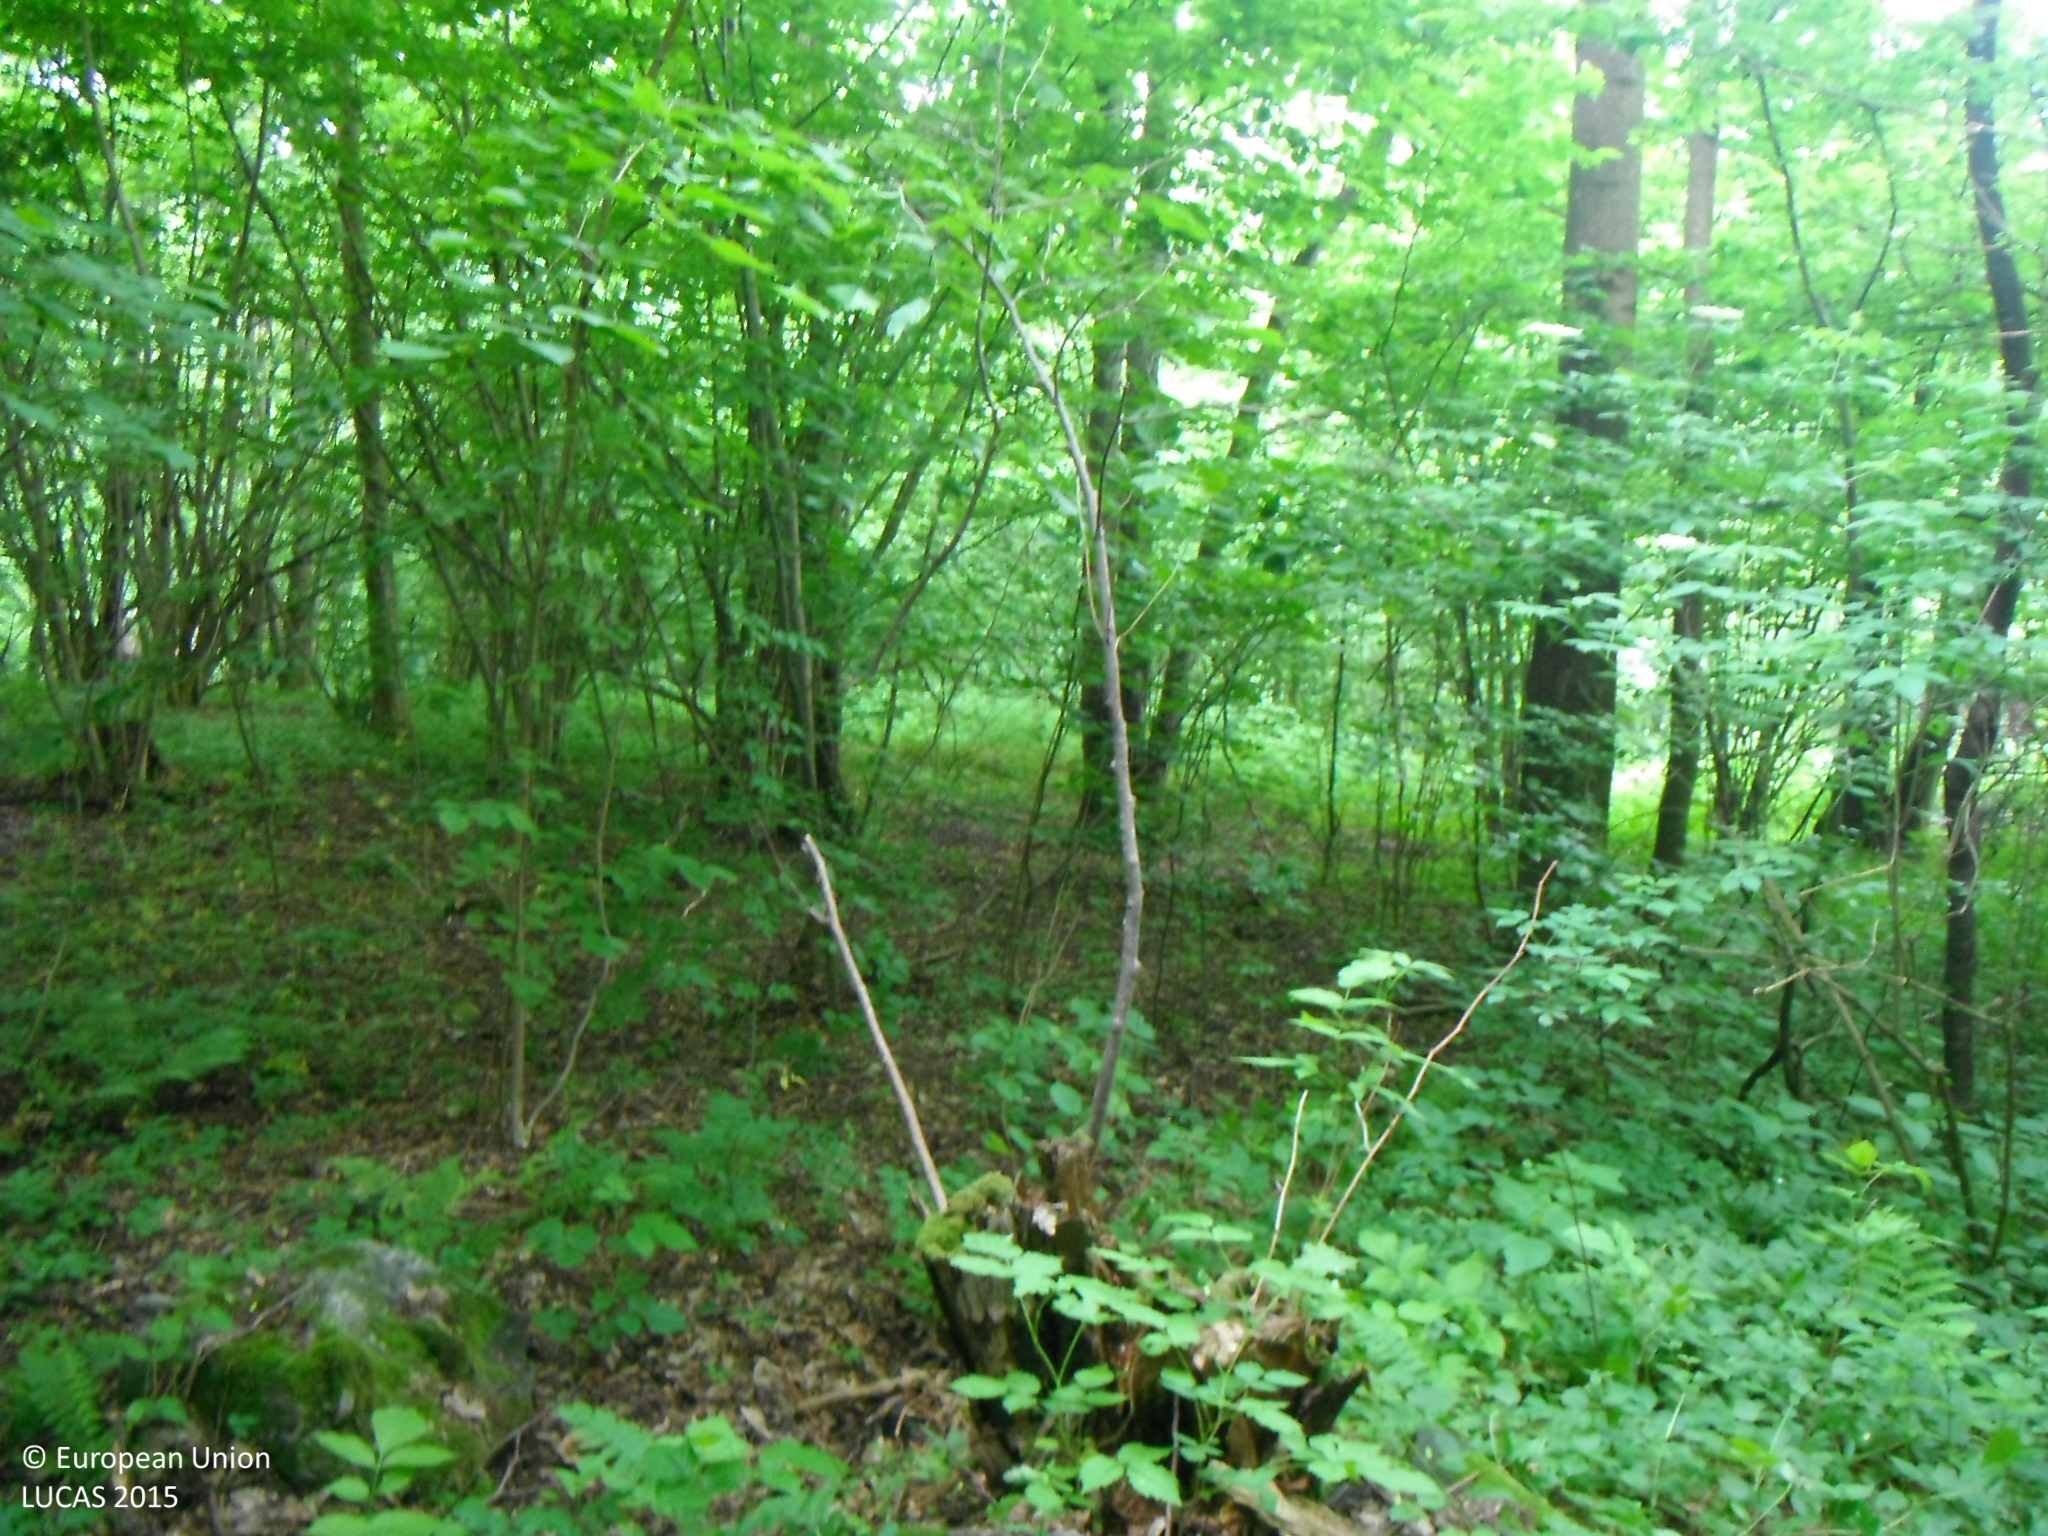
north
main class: Woodland
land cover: Broadleaved woodland
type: non-riverine alder, birch or aspen forest
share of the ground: > 75 %
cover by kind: broadleaved forest trees 90 %, shrubs 5 %, herbaceous plants 5 %
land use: Forestry
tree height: > 5 m
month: June
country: SK
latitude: 48.6448
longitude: 19.9235
